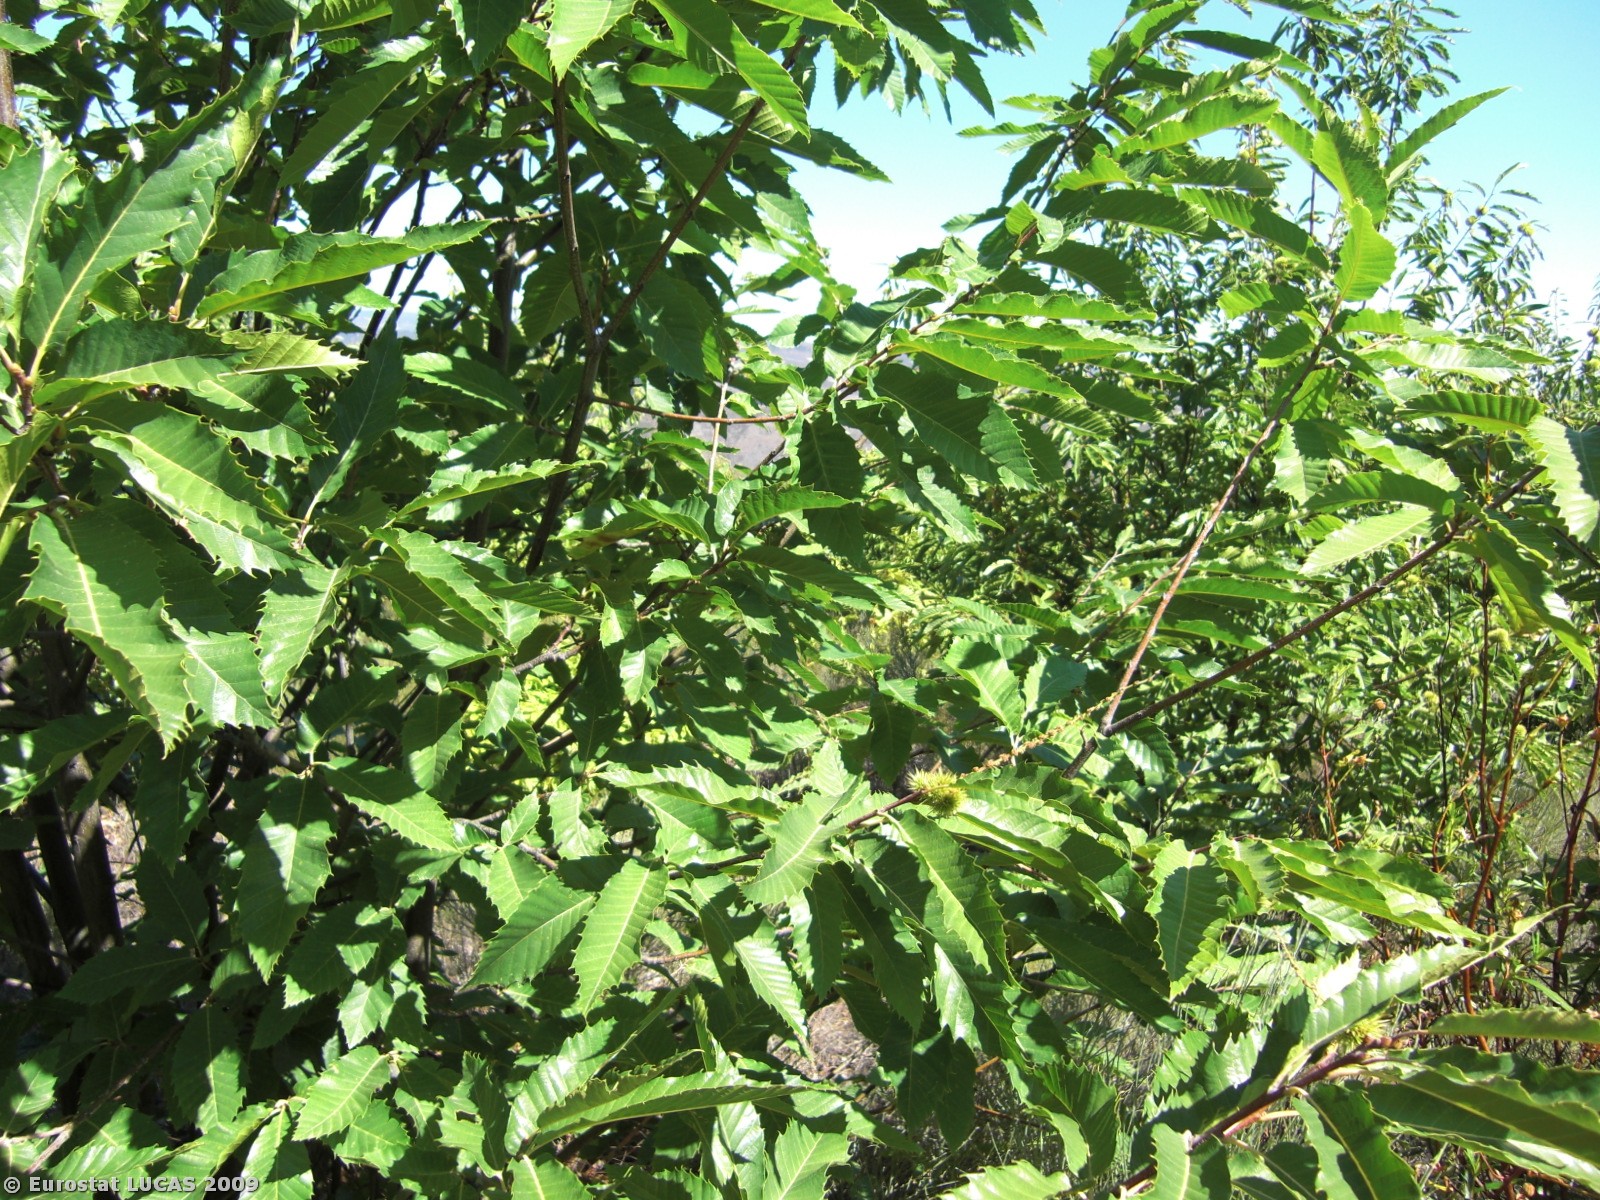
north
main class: Woodland
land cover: Broadleaved woodland
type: thermophilous deciduous forest
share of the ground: 25 - 50 %
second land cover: Spontaneously vegetated surfaces
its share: 25 - 50 %
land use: Forestry
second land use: Fallow land
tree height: > 5 m
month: August
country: PT
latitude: 41.0489
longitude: -6.9409
